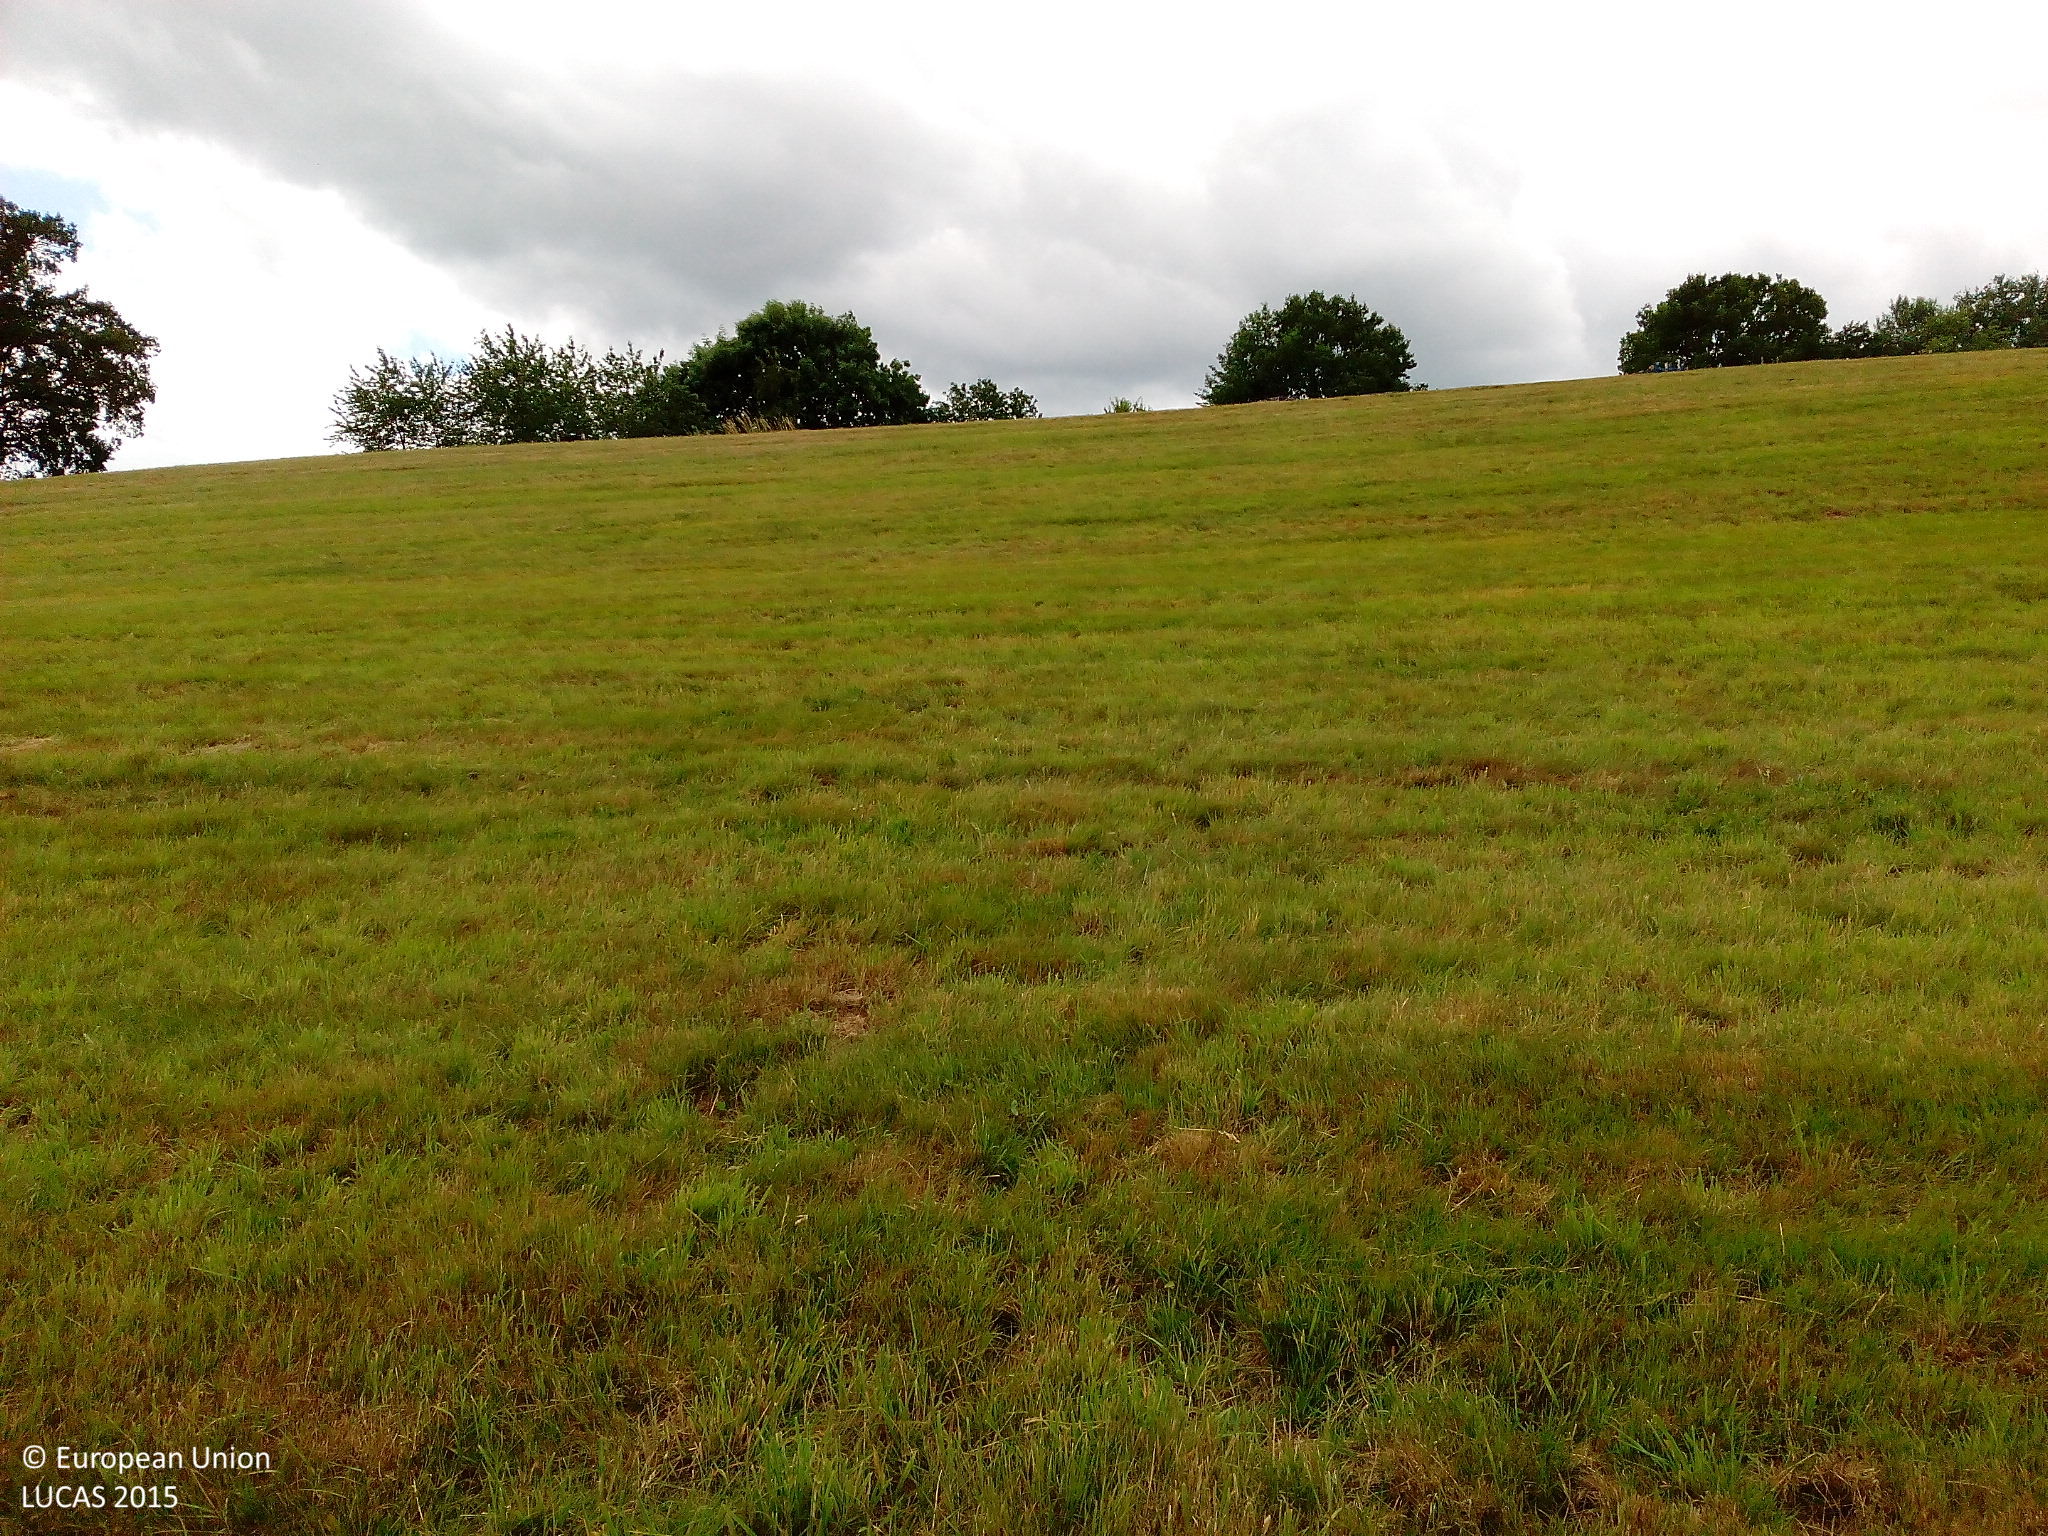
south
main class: Grassland
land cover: Grassland without tree/shrub cover
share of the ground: > 75 %
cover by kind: herbaceous plants 100 %
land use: Agriculture (excluding fallow land and kitchen gardens)
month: July
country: DE
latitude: 51.1011
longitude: 9.8715
